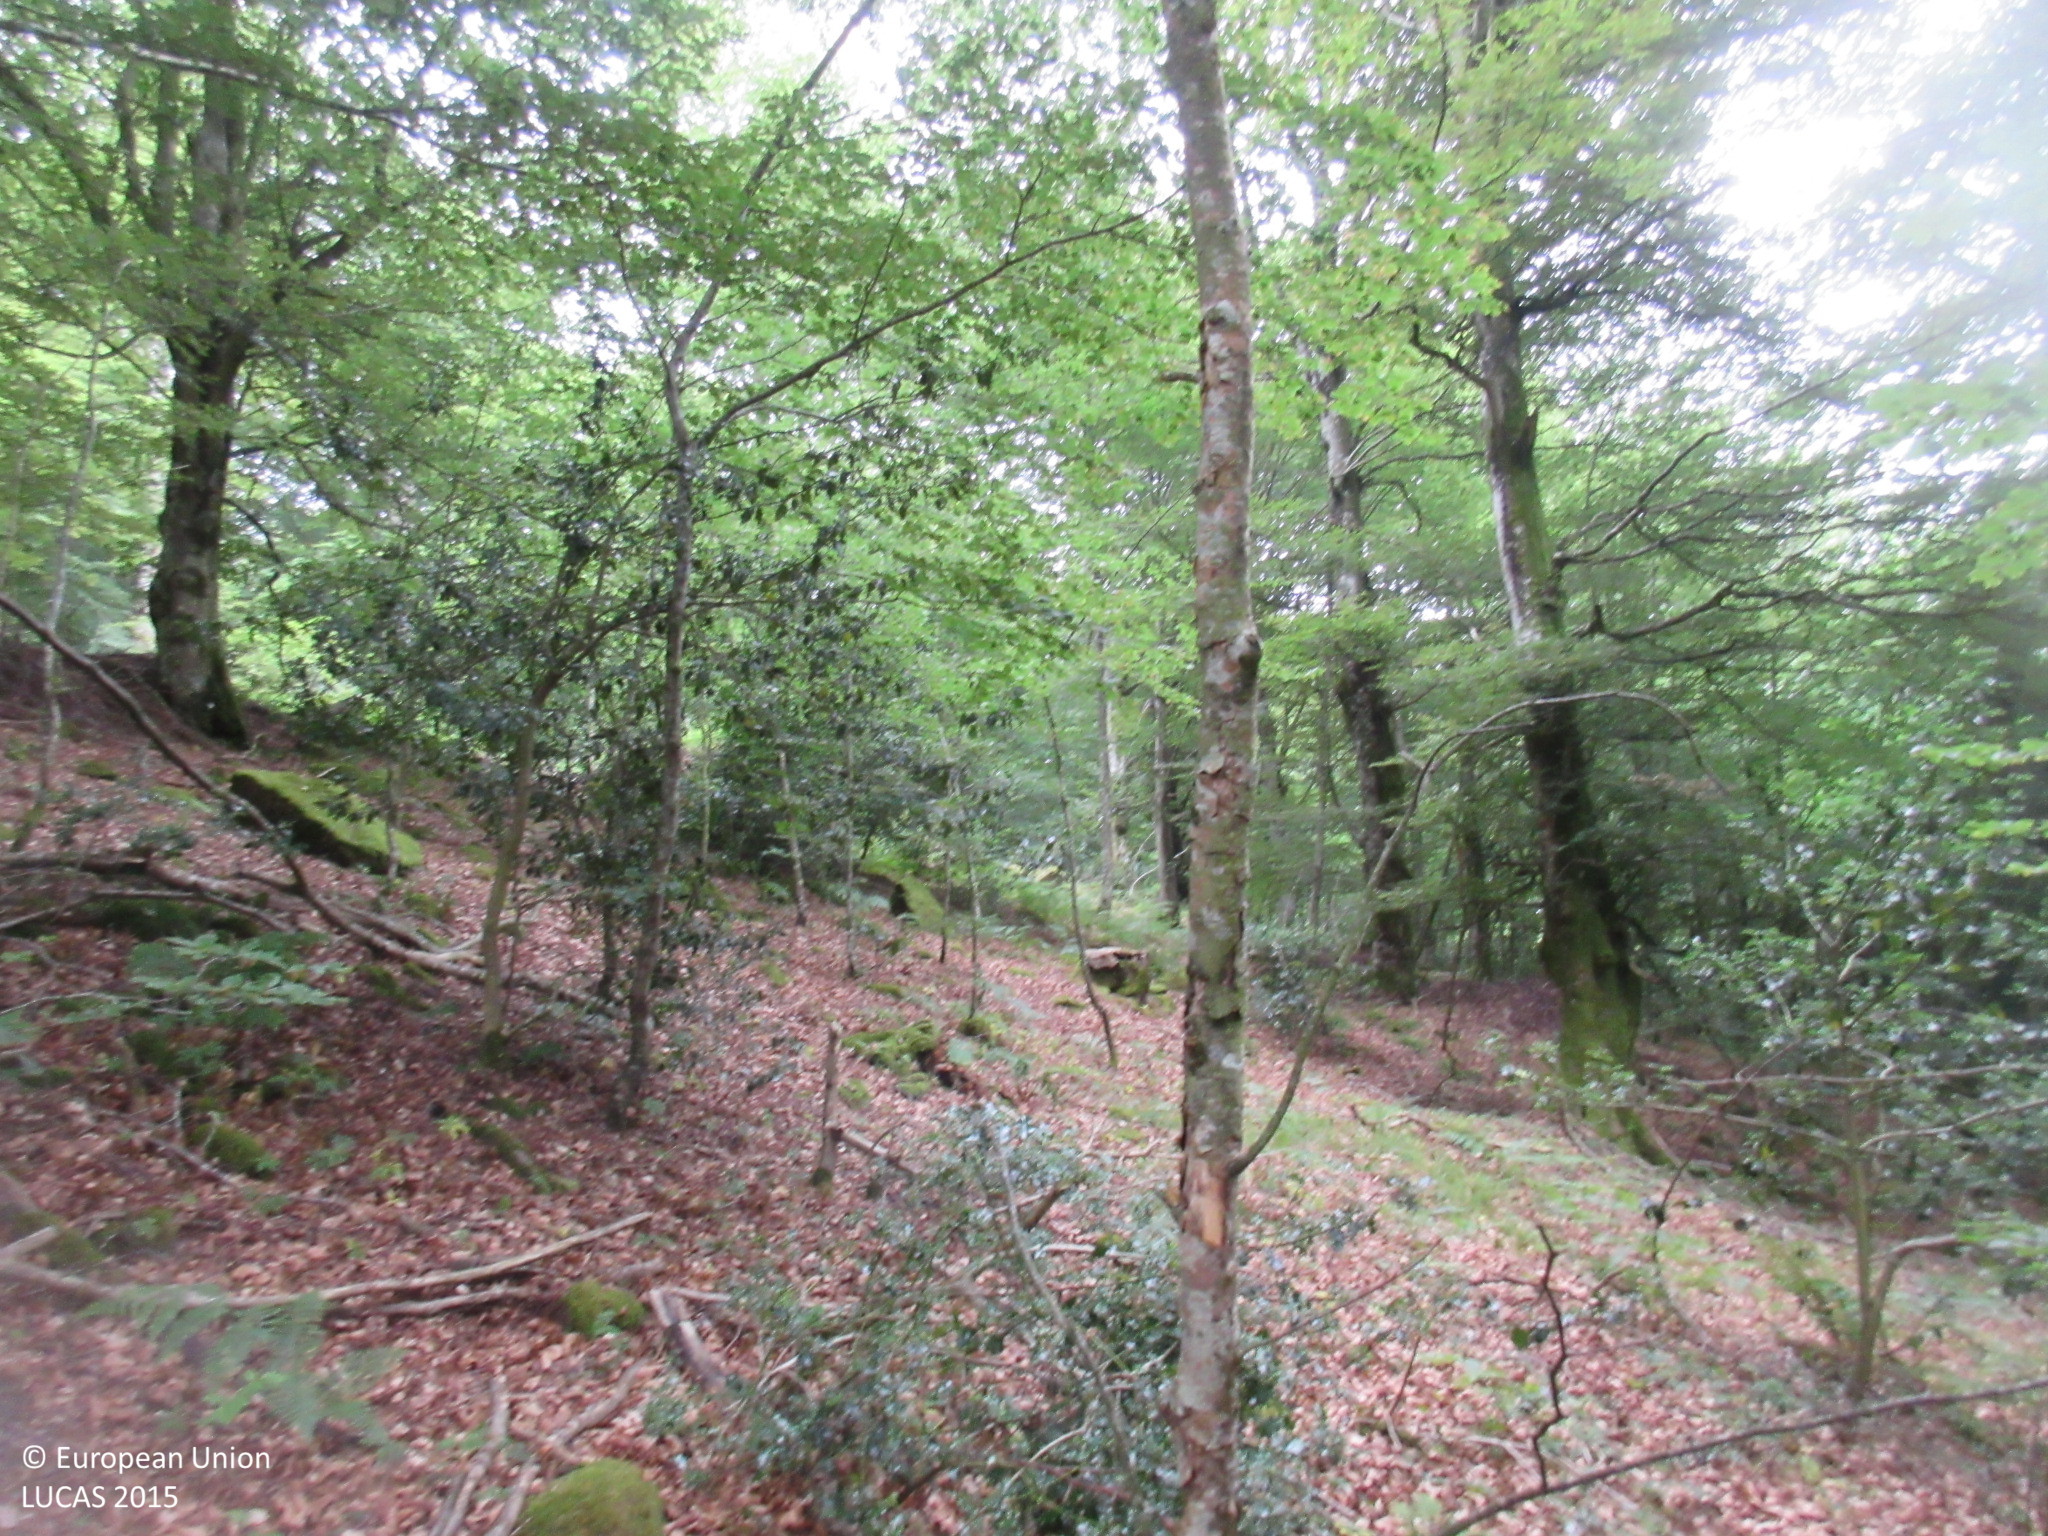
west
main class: Woodland
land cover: Broadleaved woodland
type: beech forest
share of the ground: > 75 %
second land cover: Shrubland without tree cover
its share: < 10 %
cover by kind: broadleaved forest trees 100 %
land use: Forestry
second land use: Agriculture (excluding fallow land and kitchen gardens)
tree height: > 5 m
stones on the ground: 10 - 25 %
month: July
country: ES
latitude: 43.0763
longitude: -4.0634
